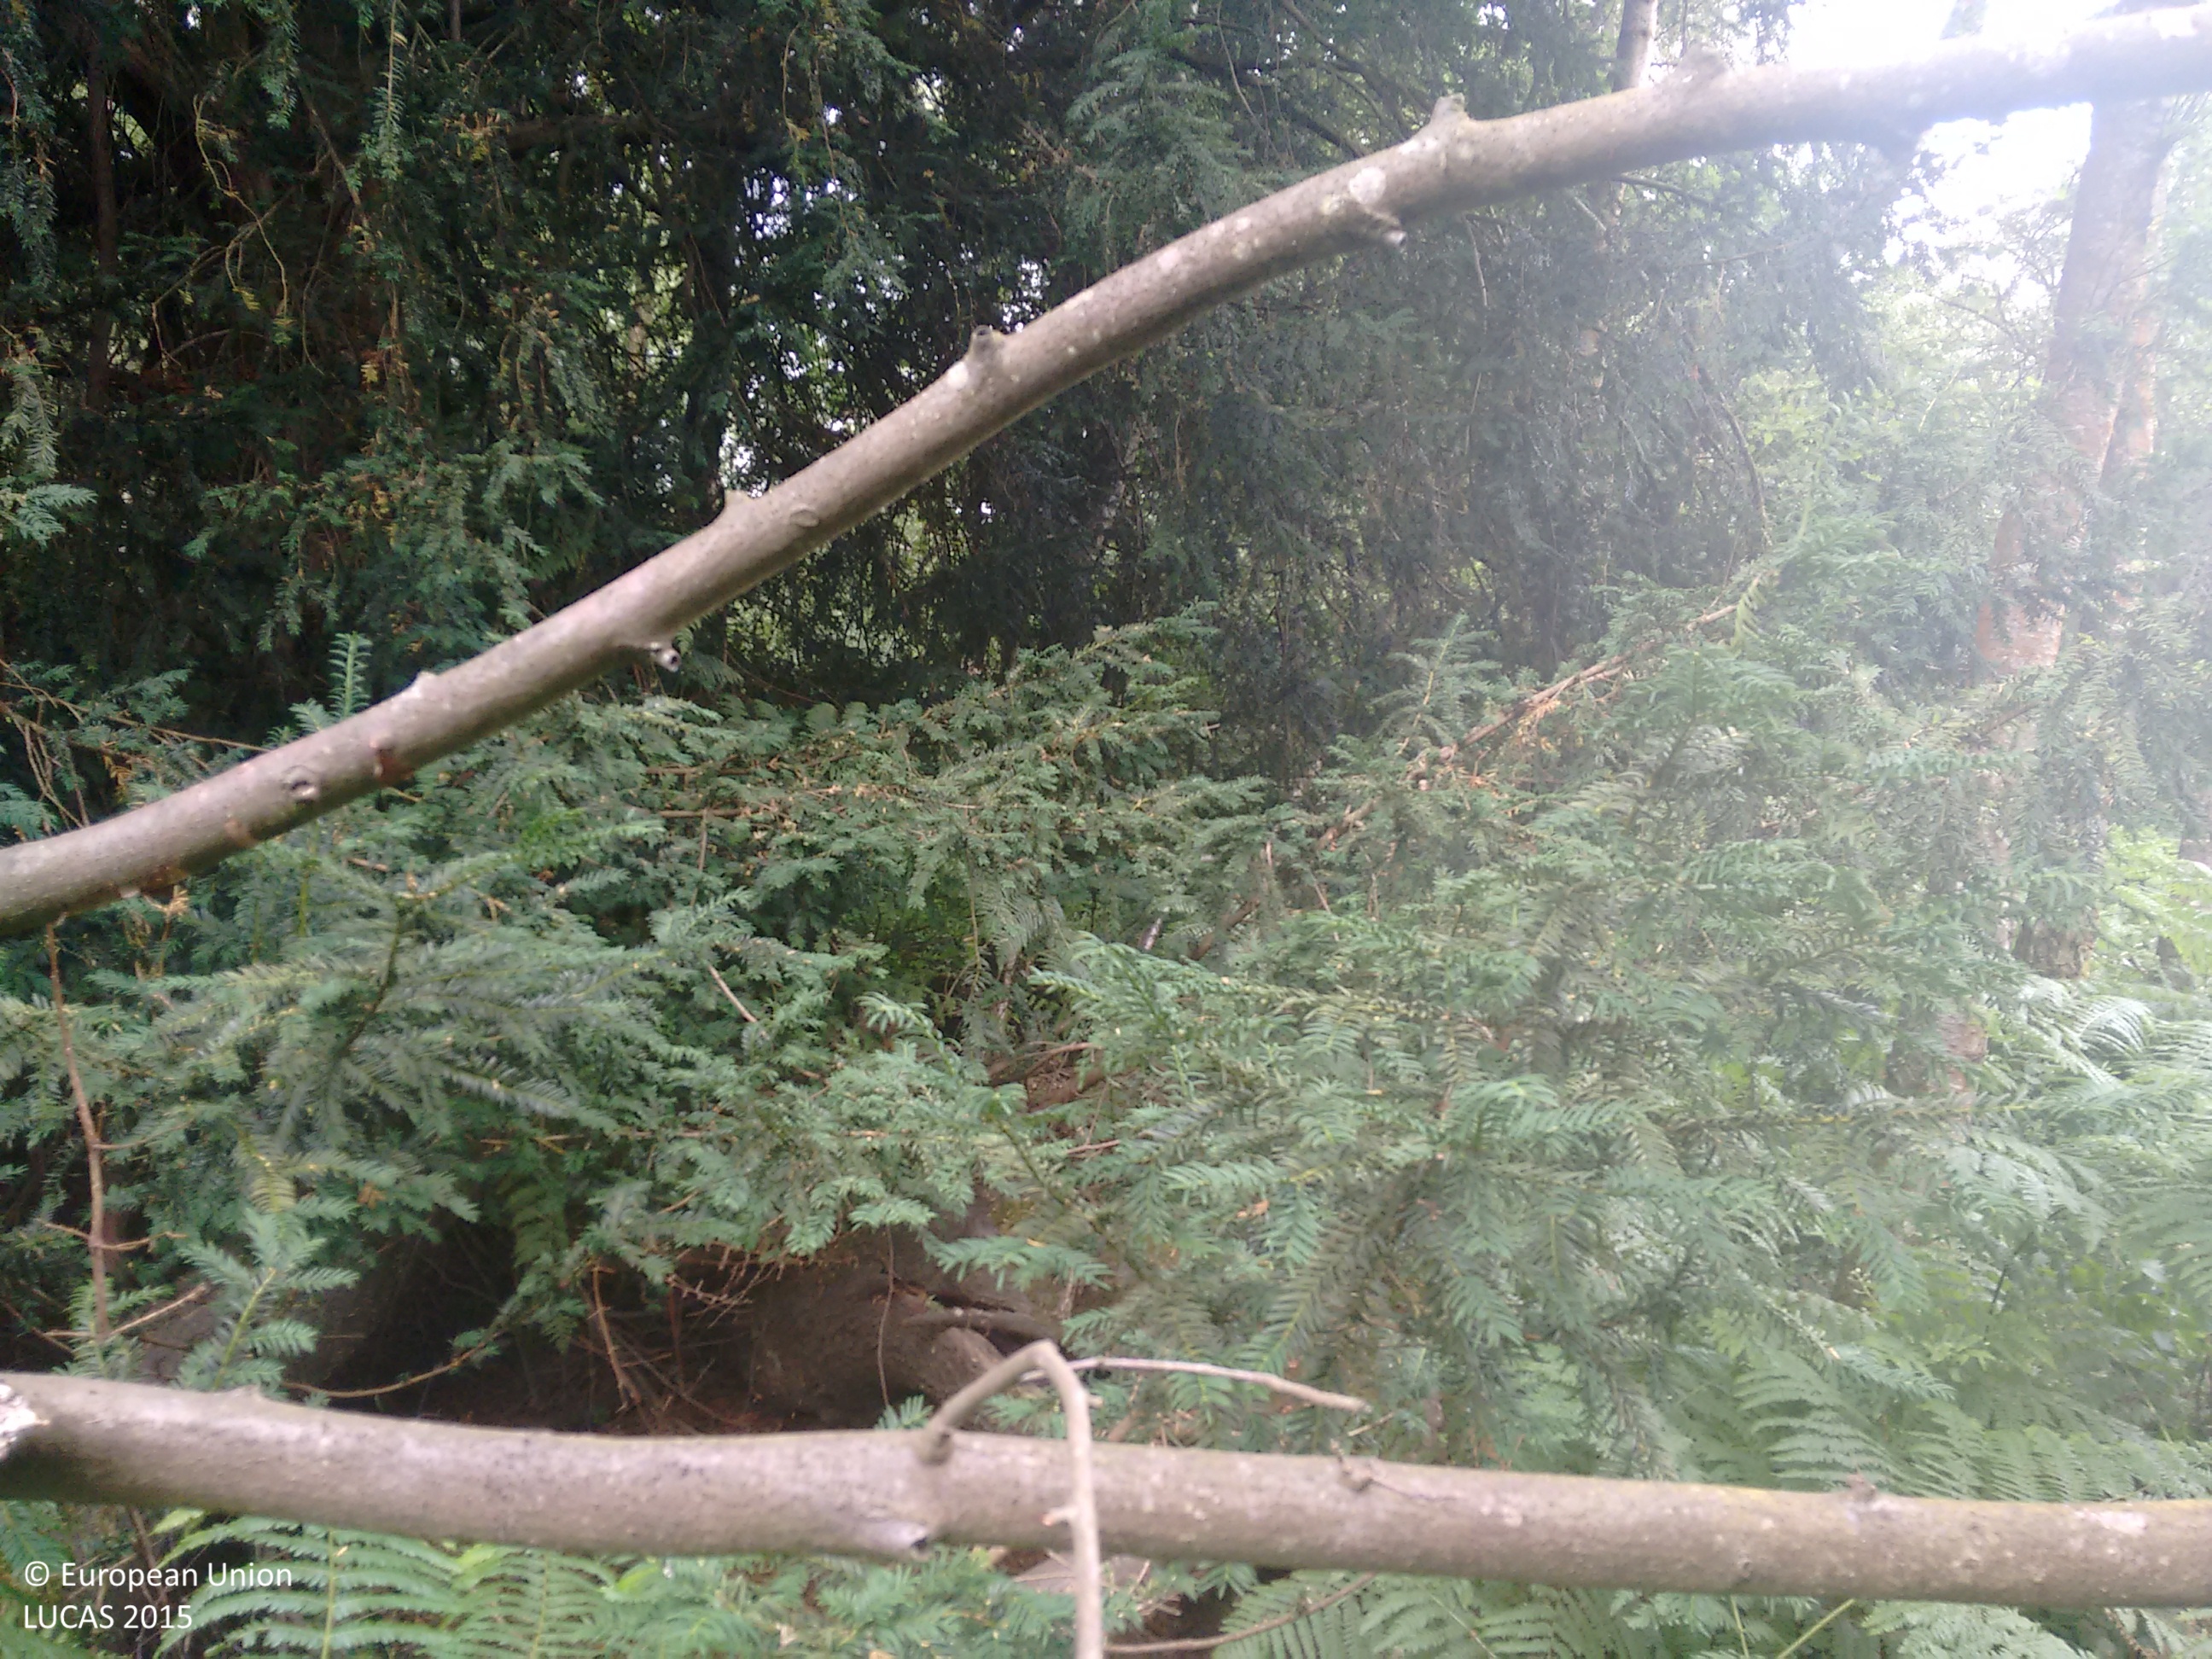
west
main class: Woodland
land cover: Other mixed woodland
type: mesophytic deciduous forest
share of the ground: > 75 %
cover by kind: broadleaved forest trees 60 %, coniferous forest trees 40 %
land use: Forestry
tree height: > 5 m
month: July
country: GB
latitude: 51.2387
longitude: -0.5090
